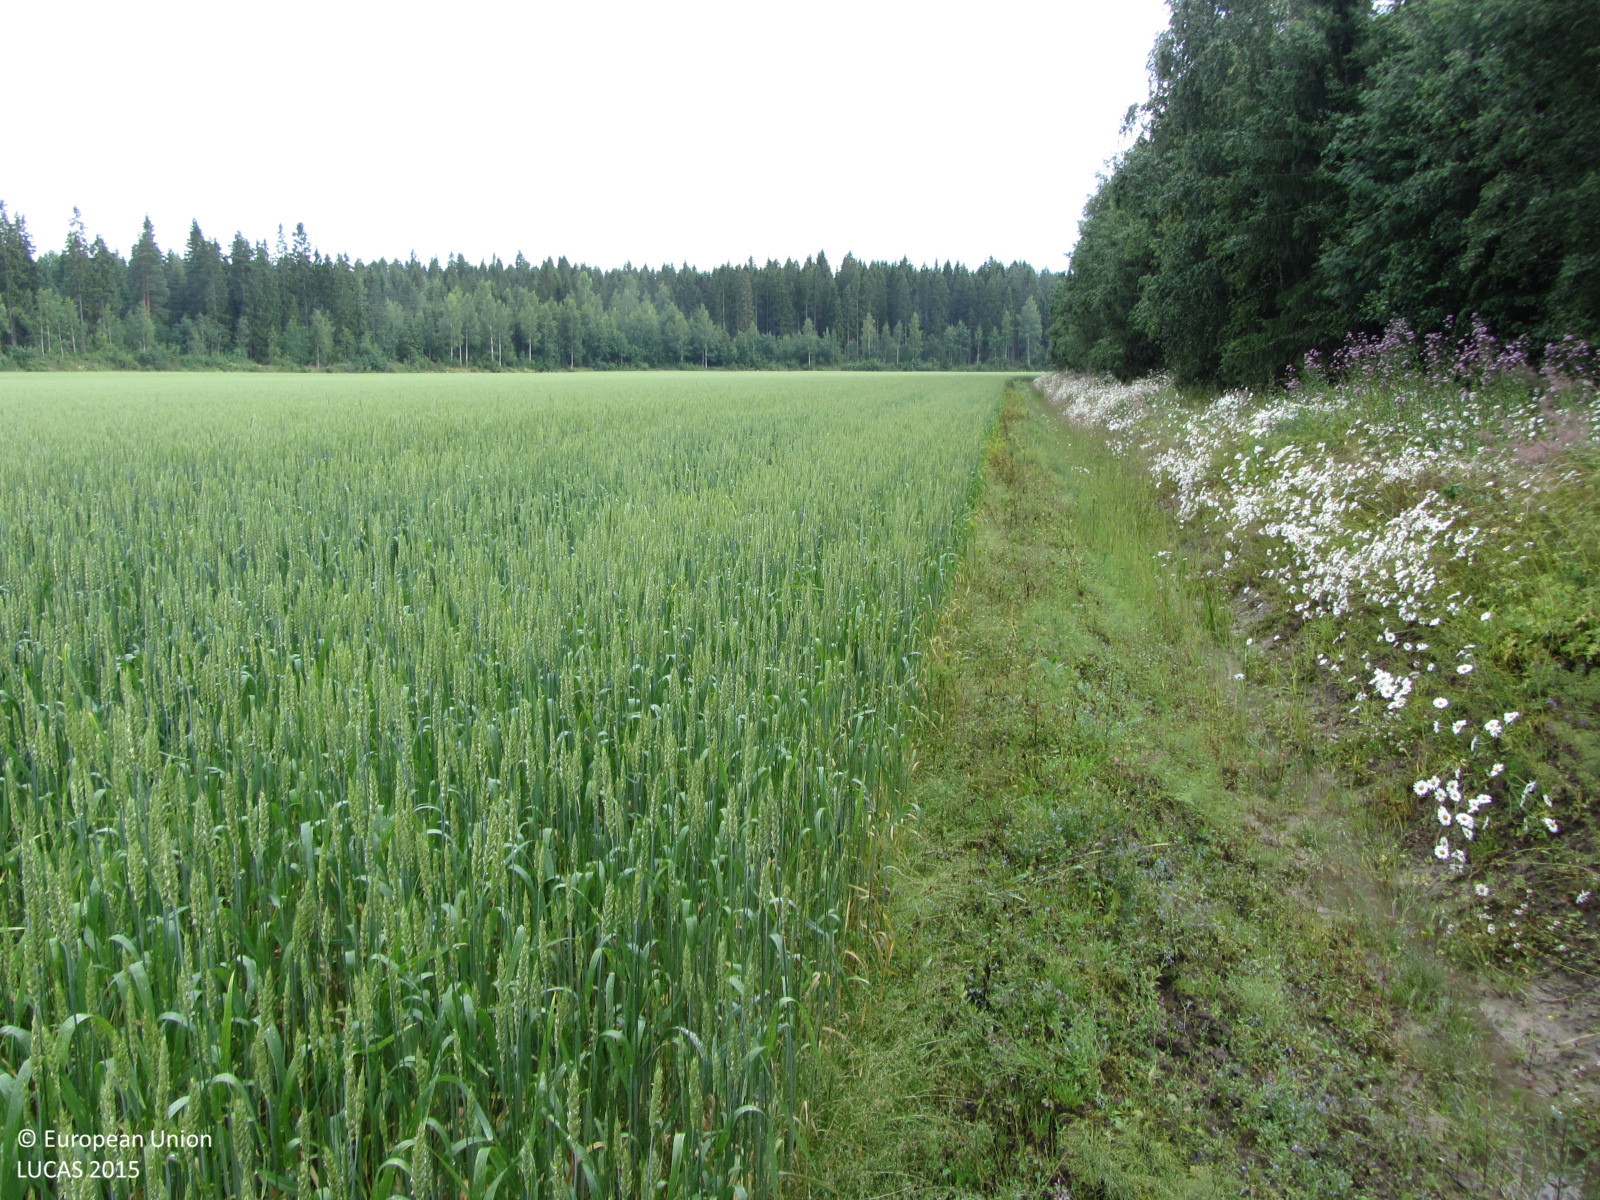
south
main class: Cropland
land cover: Common wheat
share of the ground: > 75 %
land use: Agriculture (excluding fallow land and kitchen gardens)
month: July
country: FI
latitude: 60.5704
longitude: 24.6131
